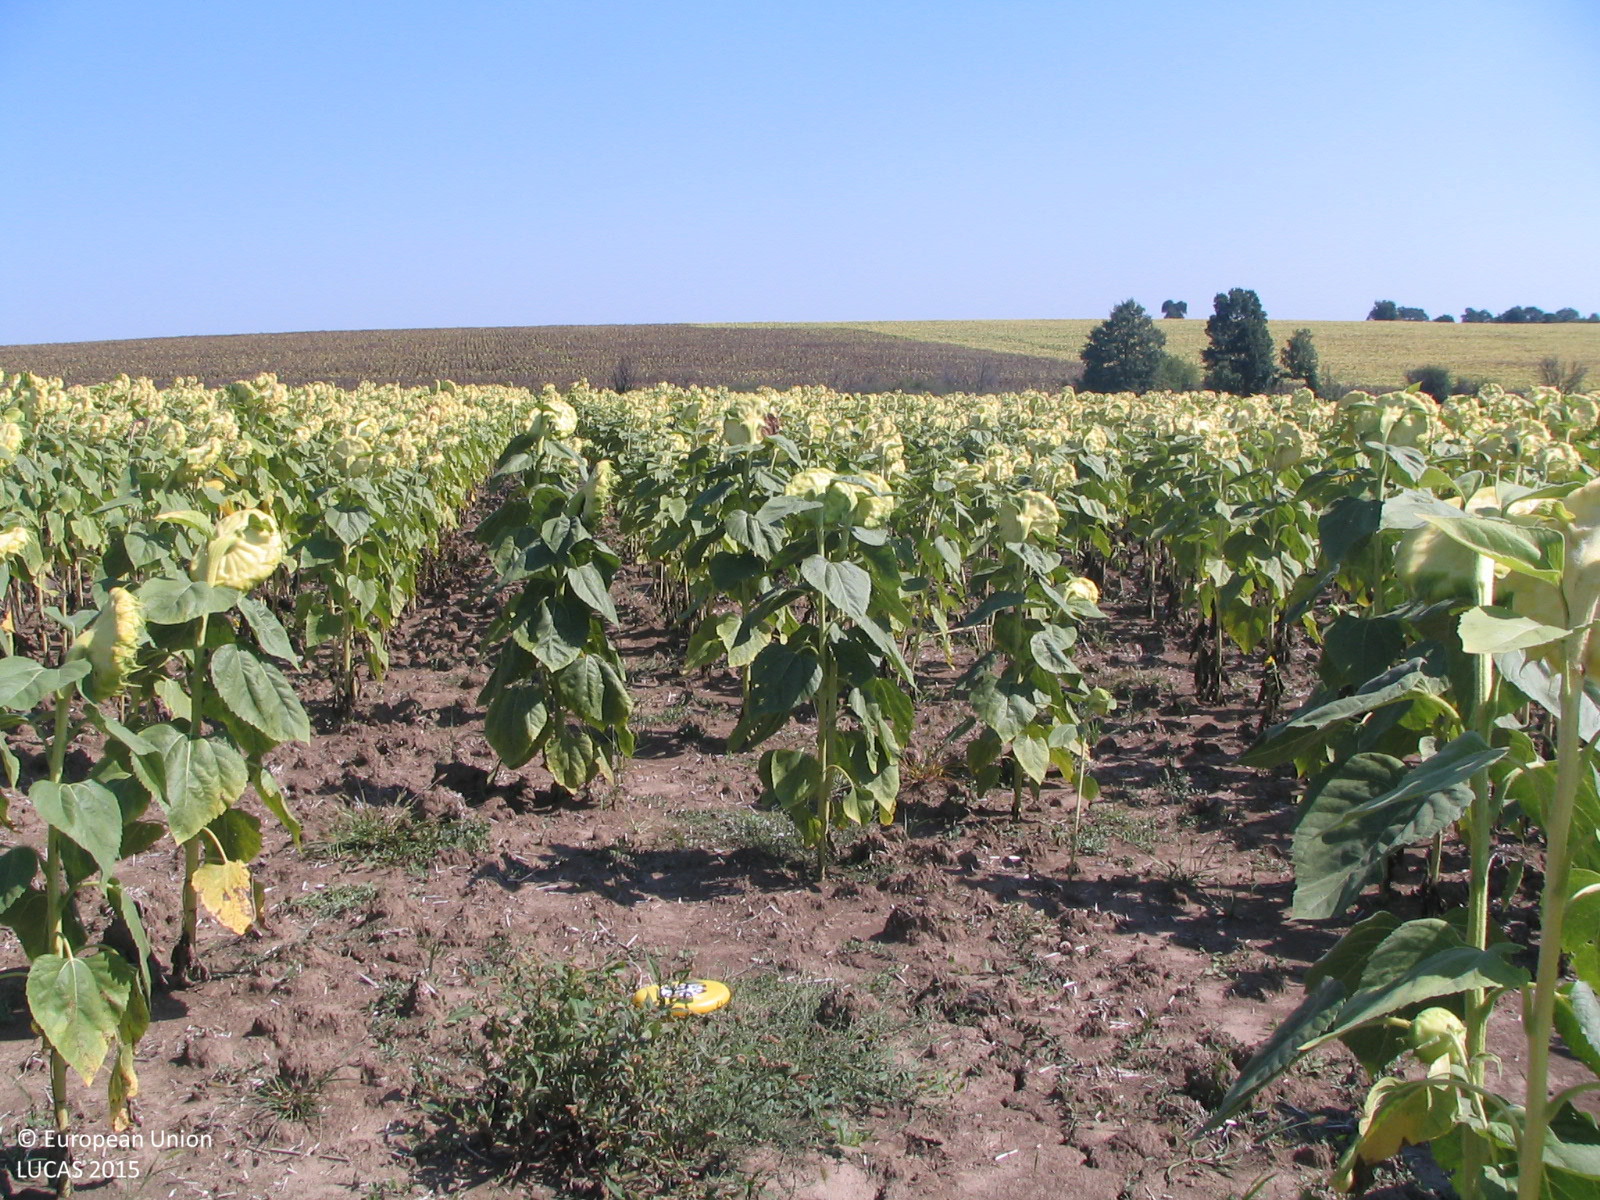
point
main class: Cropland
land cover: Sunflower
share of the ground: > 75 %
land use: Agriculture (excluding fallow land and kitchen gardens)
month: August
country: BG
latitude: 43.1838
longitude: 24.3399
